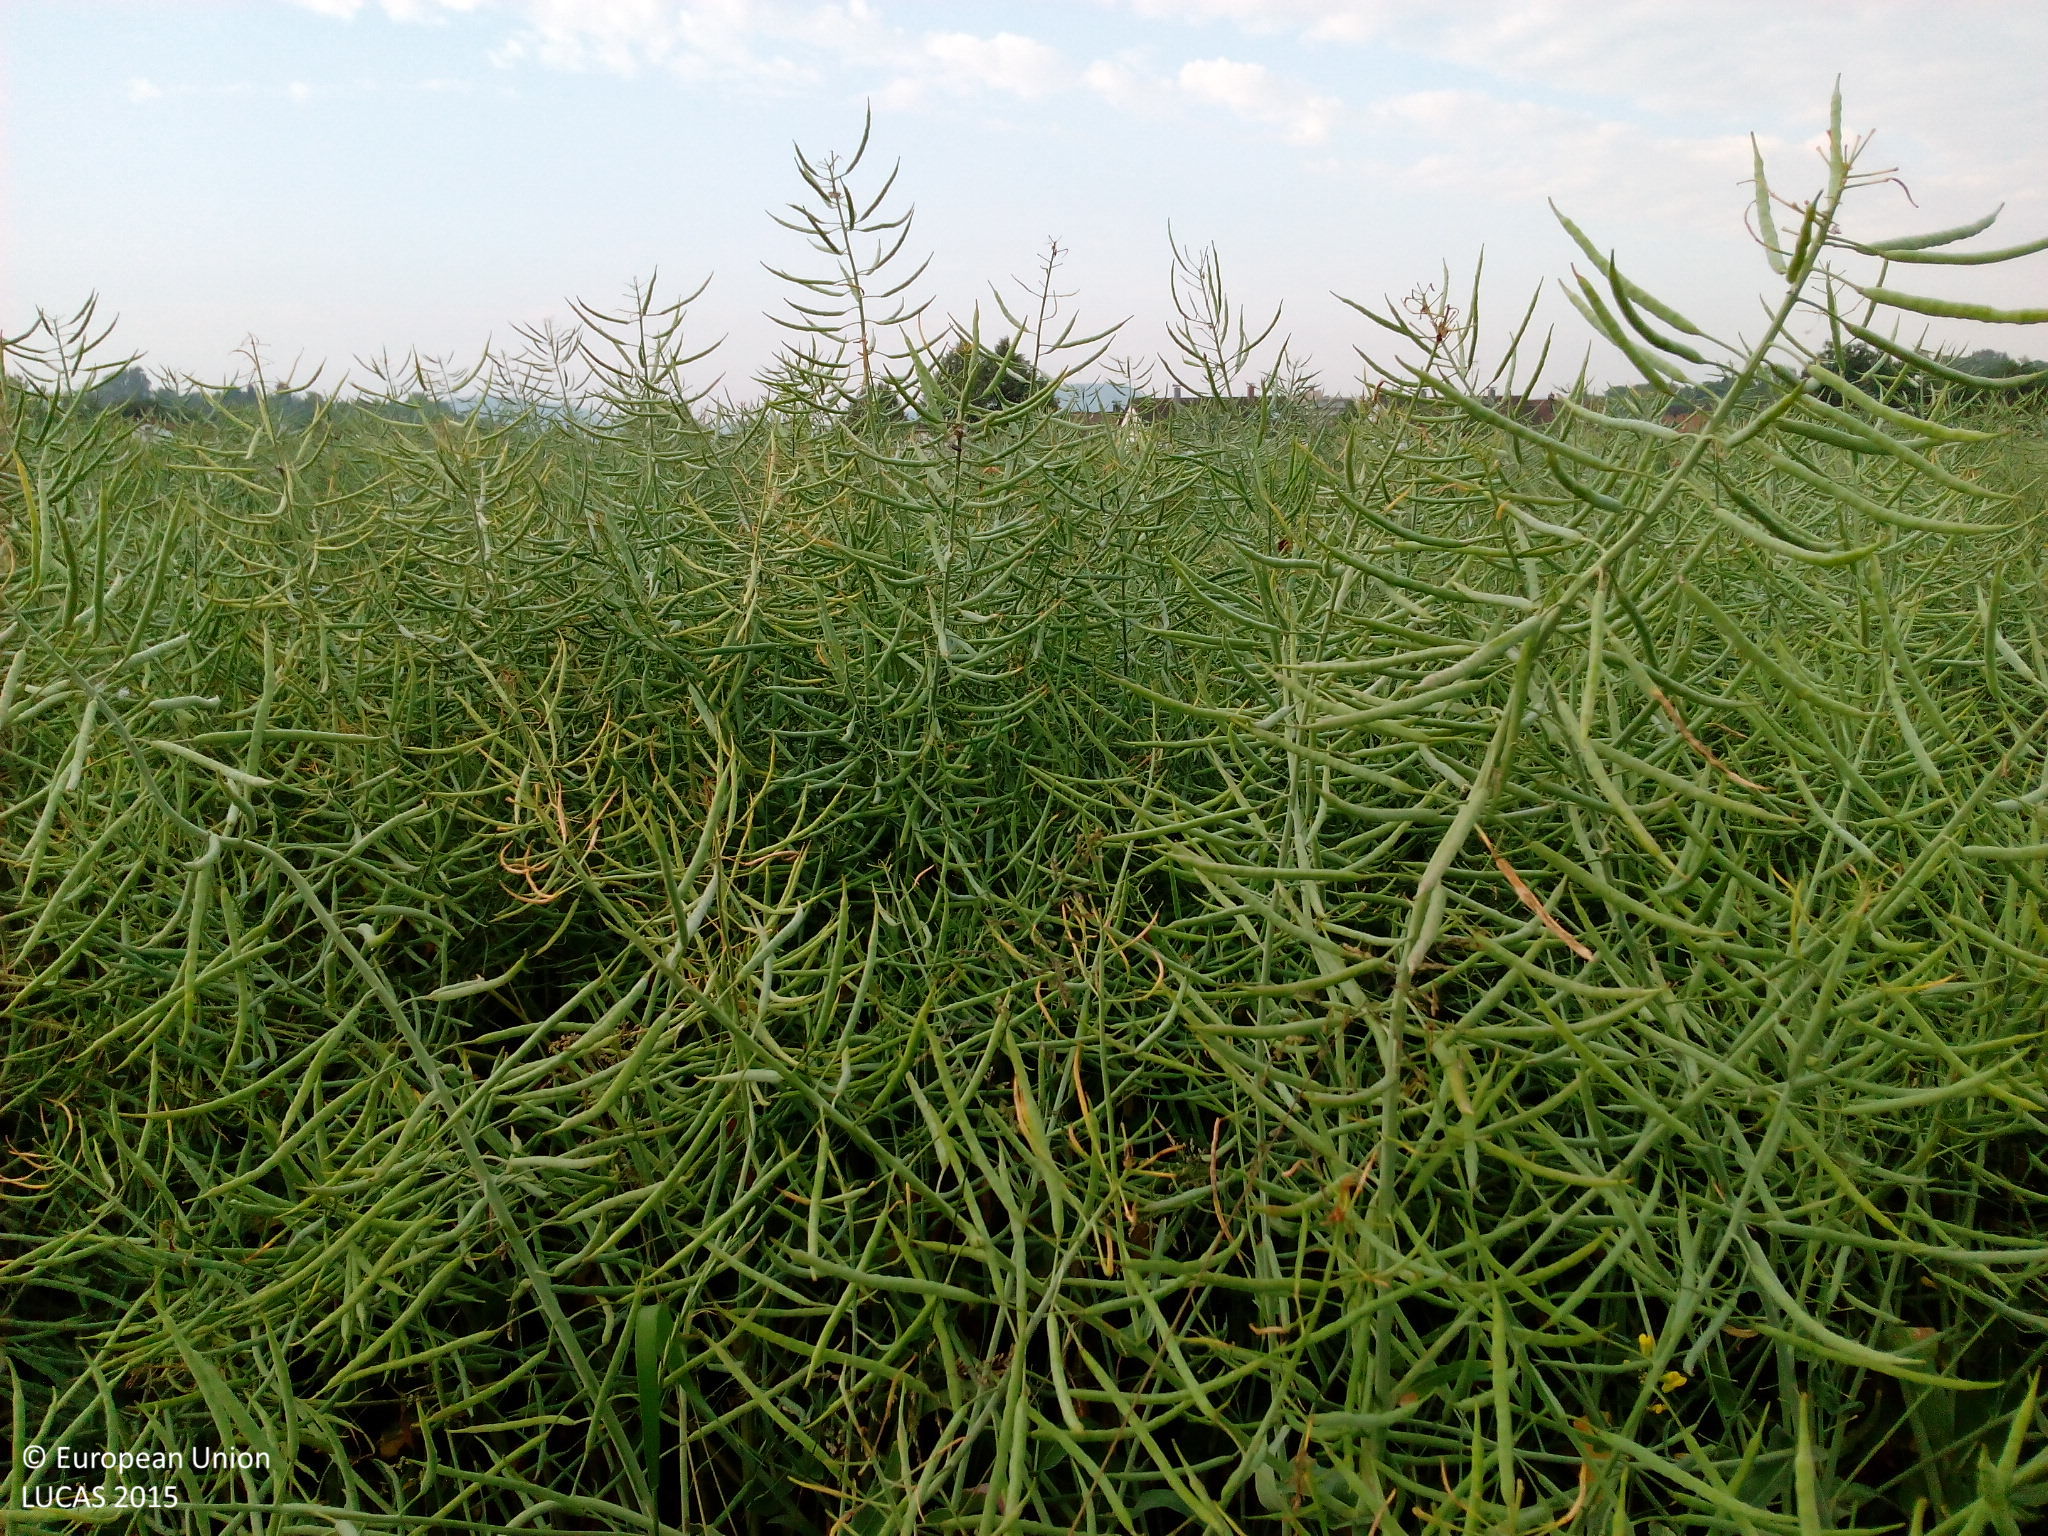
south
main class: Cropland
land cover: Rape and turnip rape
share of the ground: > 75 %
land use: Agriculture (excluding fallow land and kitchen gardens)
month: June
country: DE
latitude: 48.6909
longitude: 9.6877
